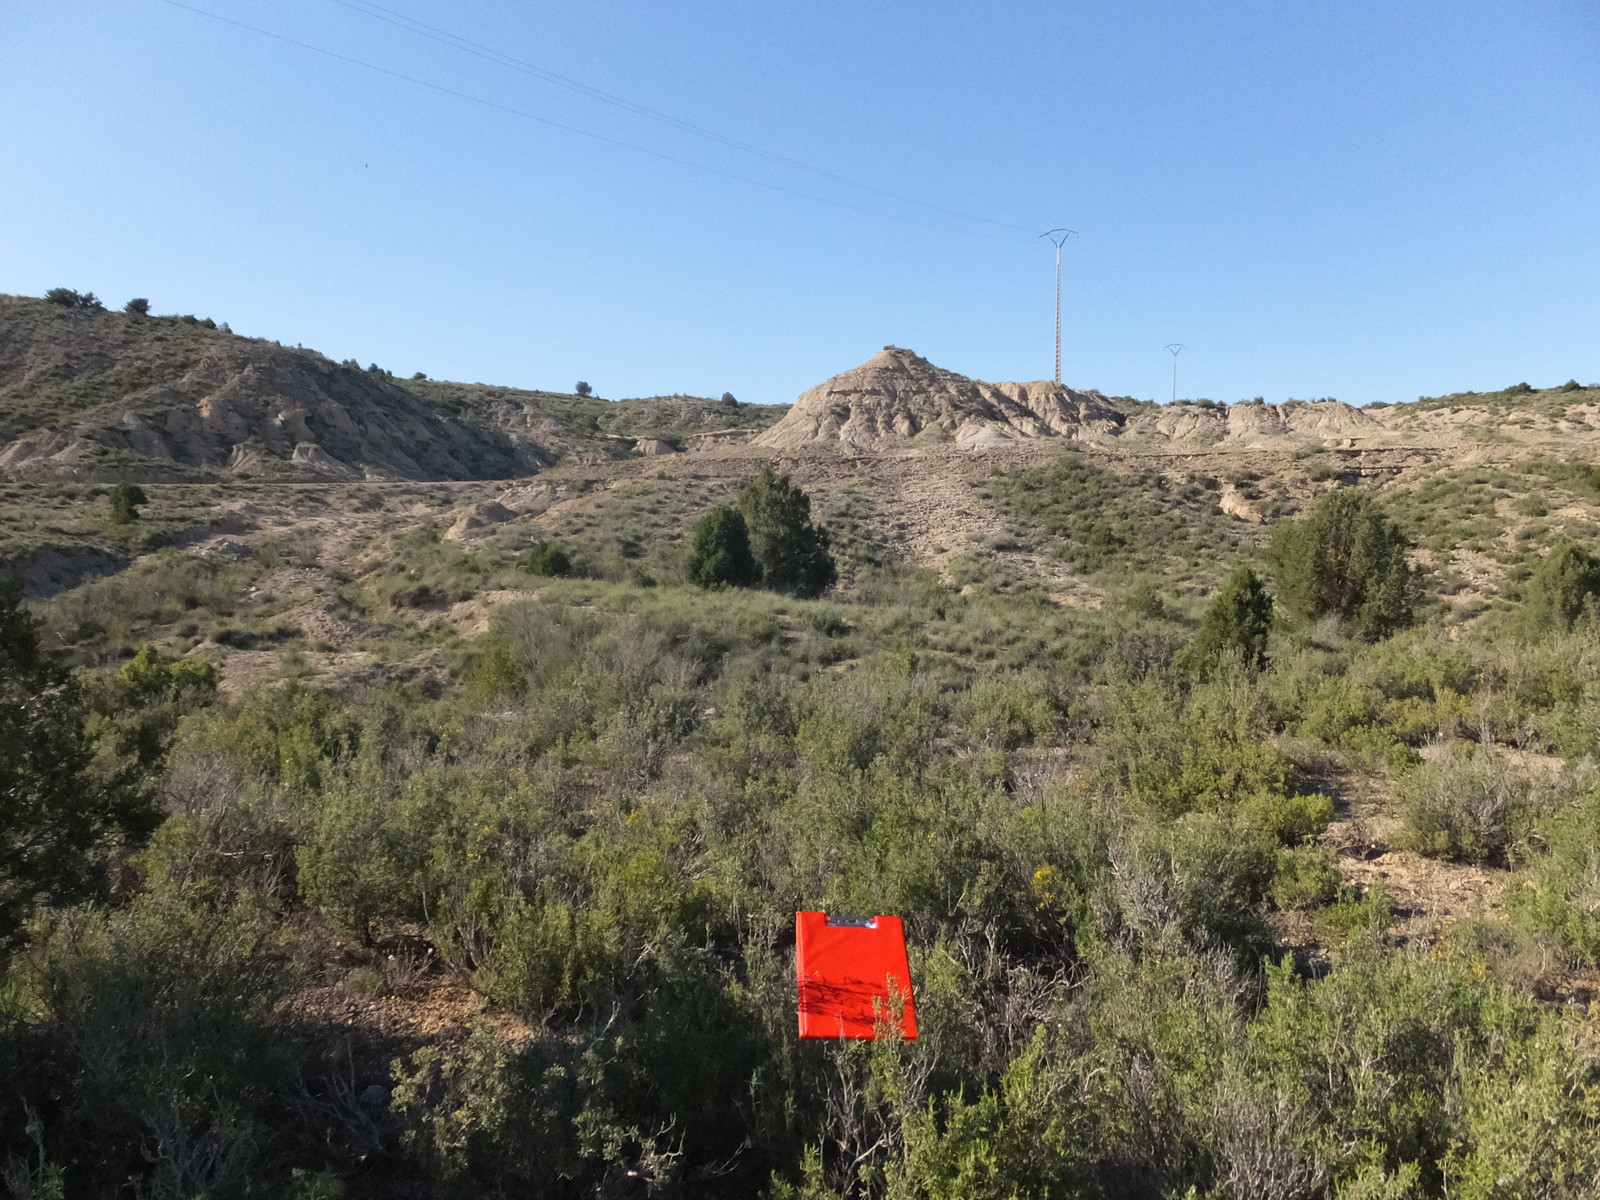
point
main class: Shrubland
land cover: Shrubland with sparse tree cover
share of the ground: > 75 %
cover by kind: shrubs 90 %, coniferous forest trees 5 %, herbaceous plants 5 %
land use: Abandoned areas
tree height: < 5 m
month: April
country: ES
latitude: 41.6813
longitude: -0.2165
